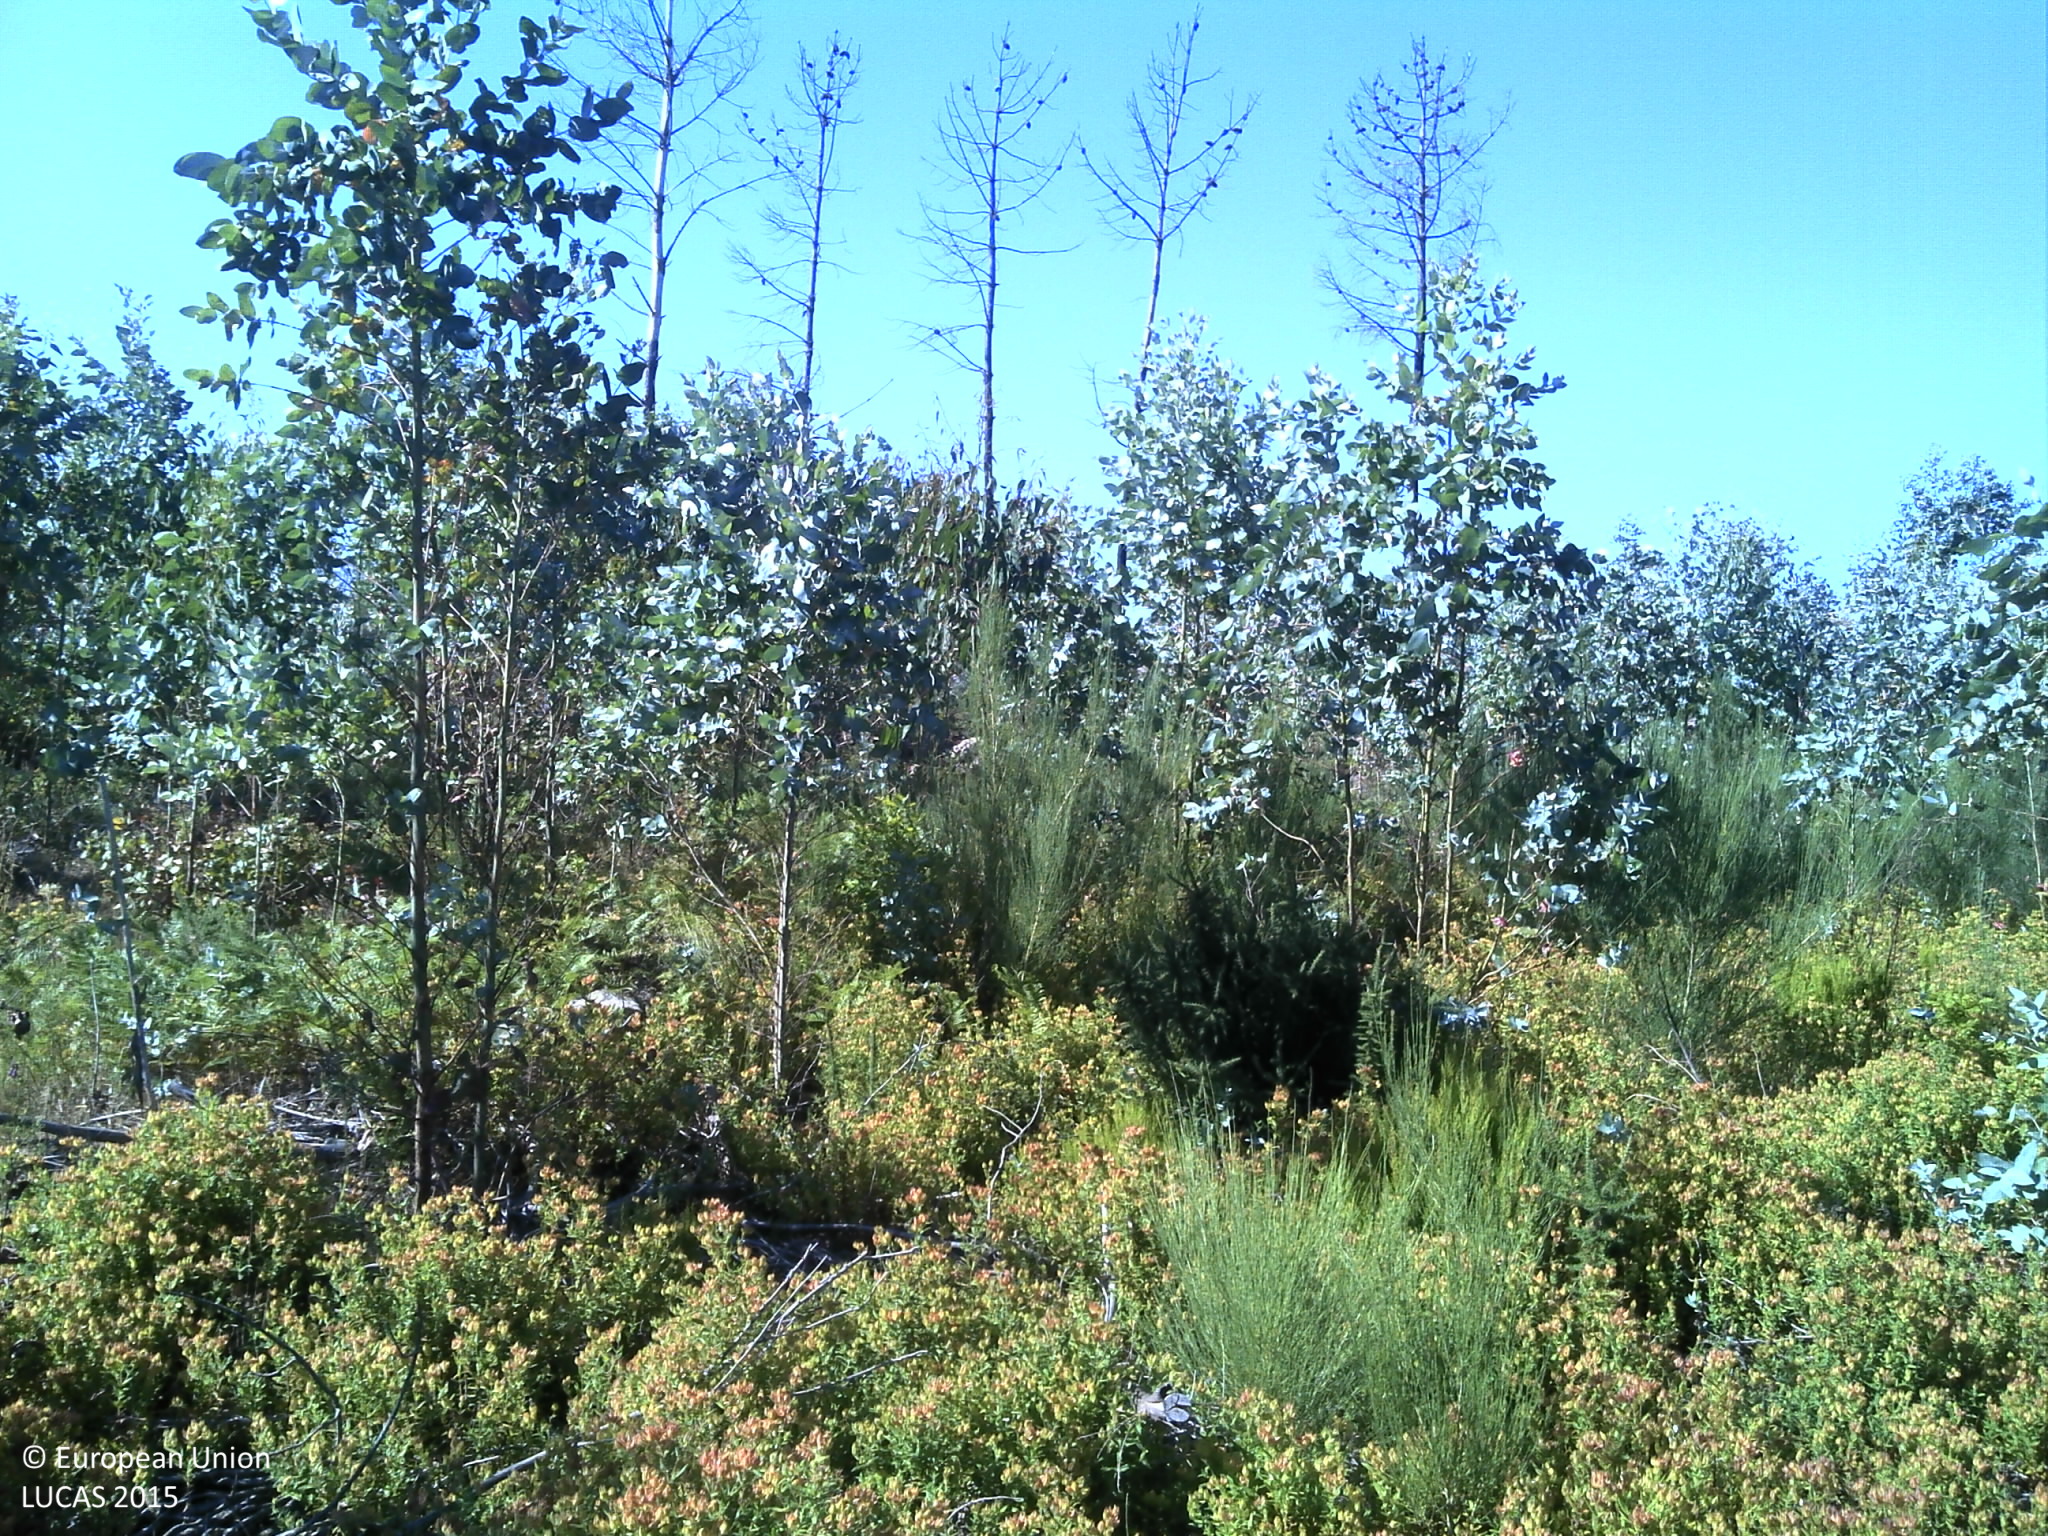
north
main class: Woodland
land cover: Broadleaved woodland
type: exotic forest
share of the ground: 25 - 50 %
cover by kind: shrubs 40 %, broadleaved forest trees 30 %, herbaceous plants 15 %, unconsolidated bare surface 15 %
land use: Forestry
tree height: < 5 m
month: June
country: PT
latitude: 40.5701
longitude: -8.2640
